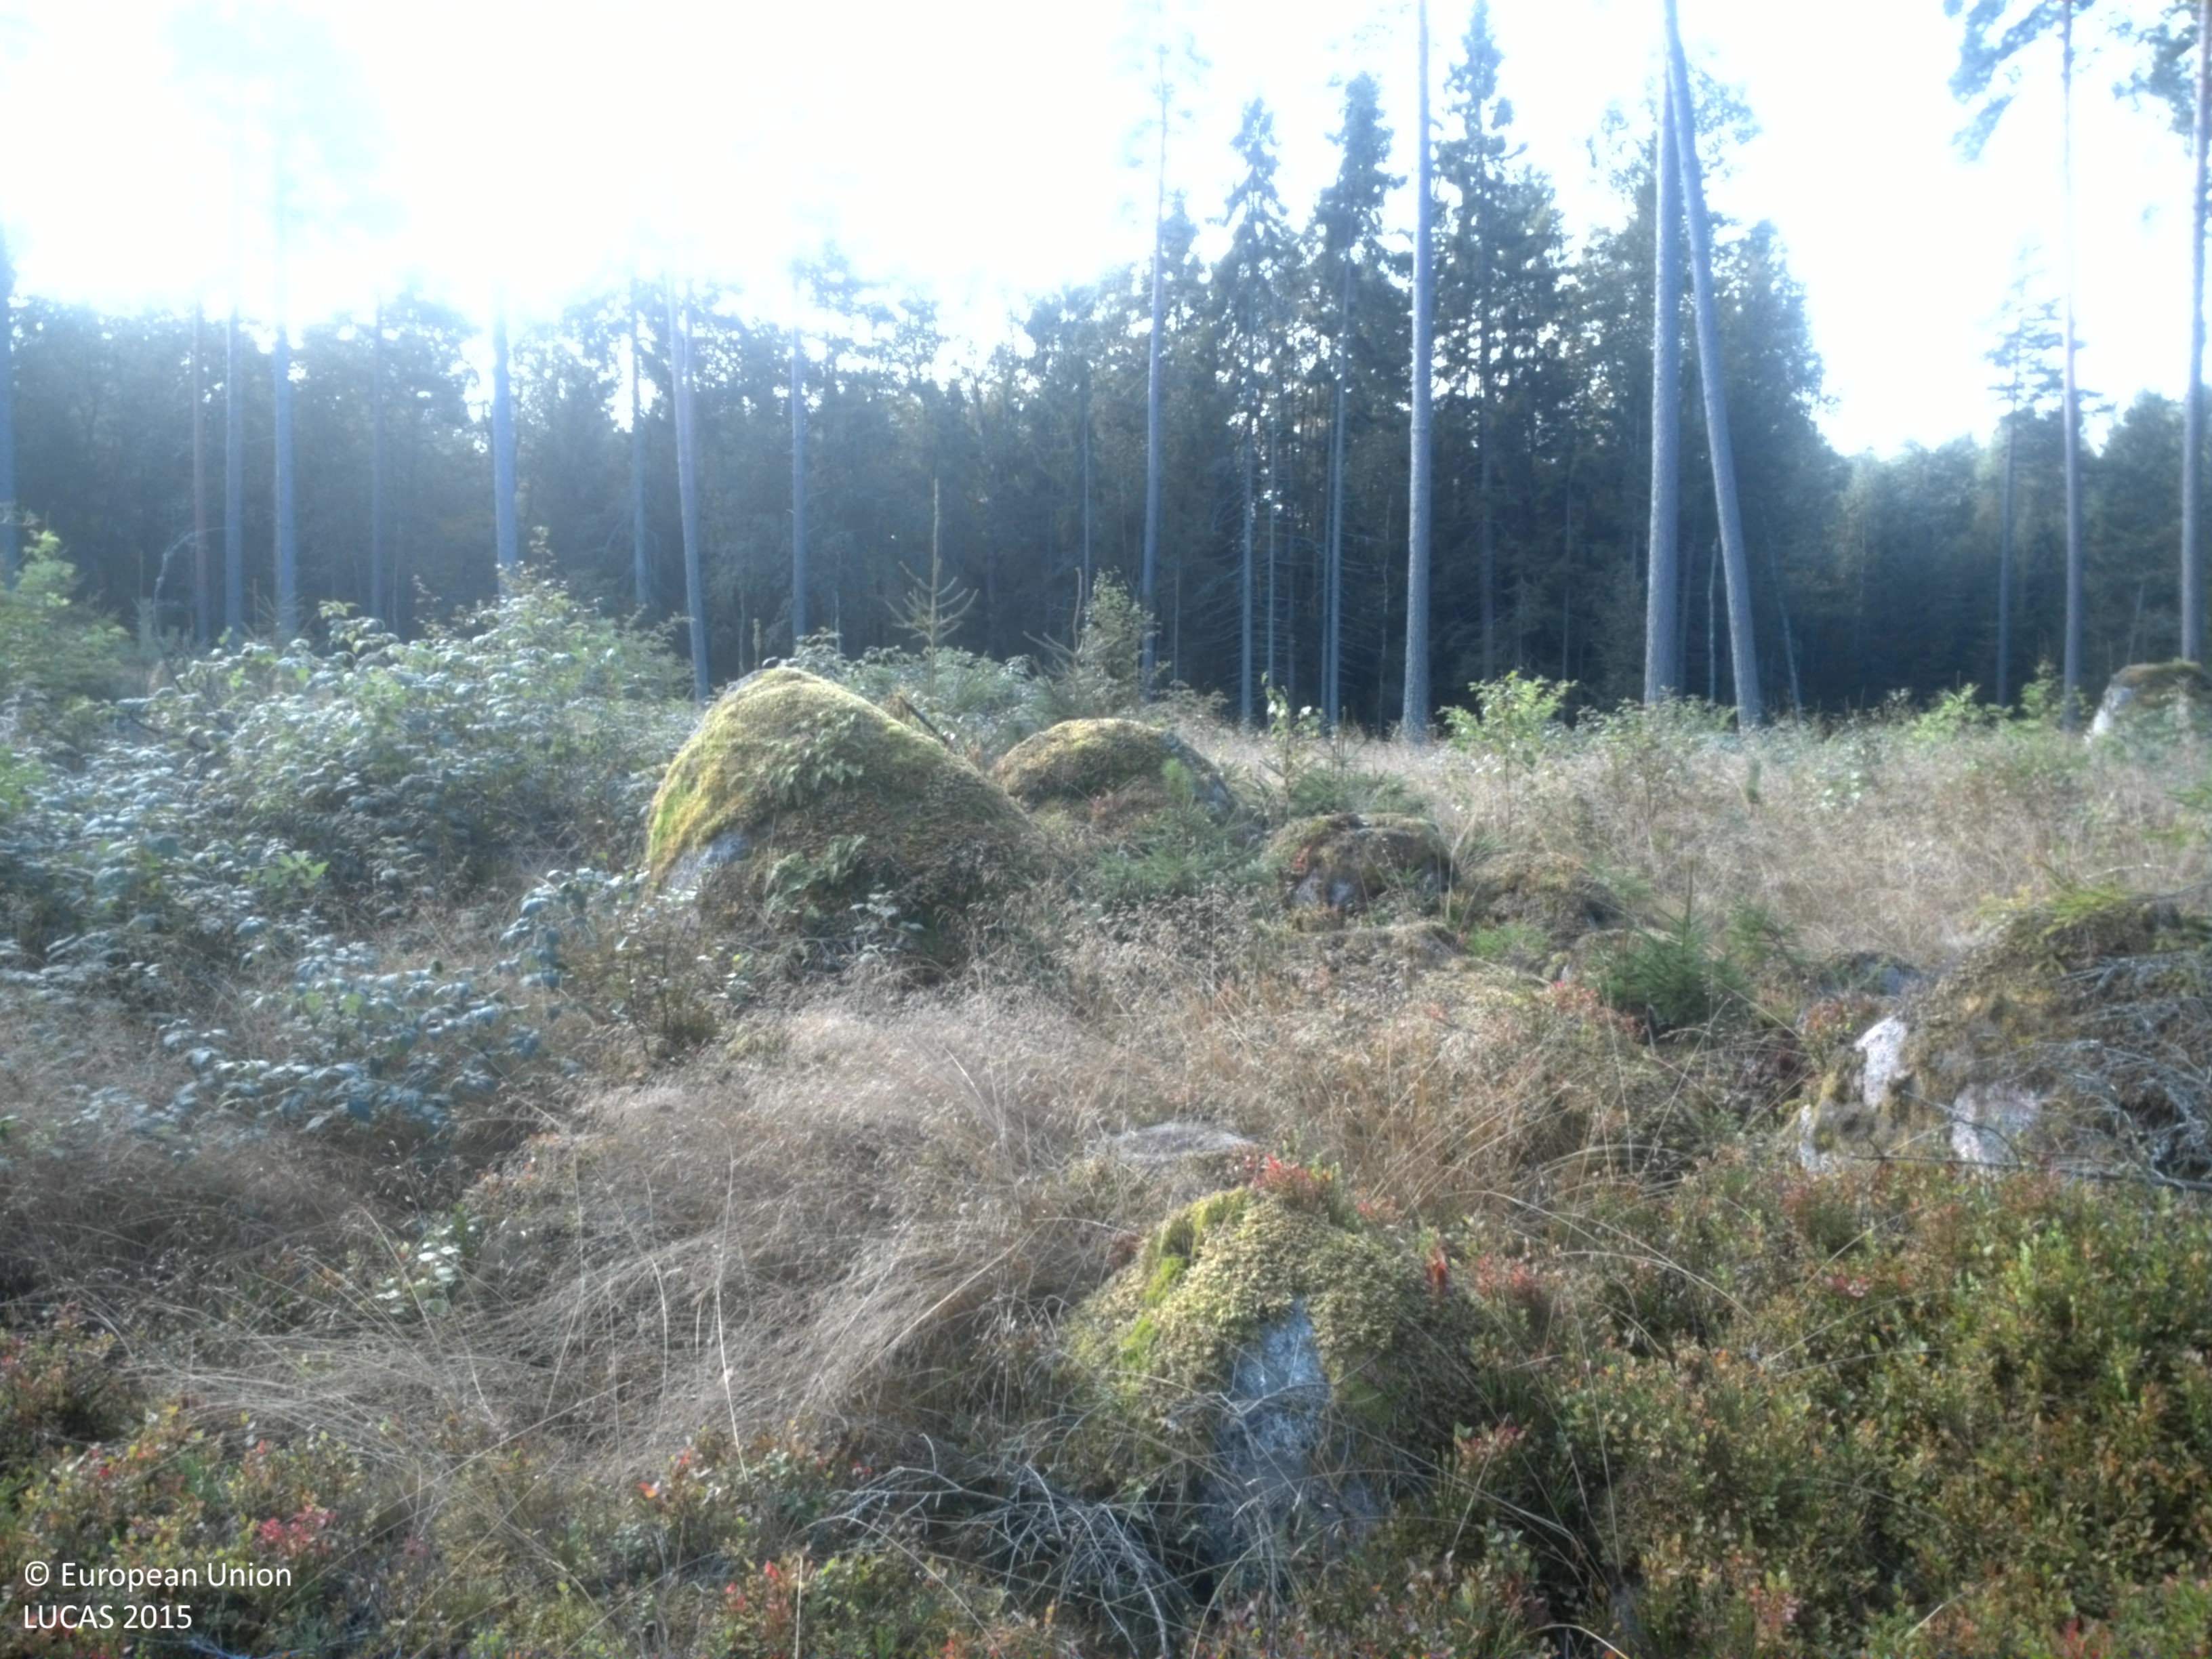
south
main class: Woodland
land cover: Pine dominated coniferous woodland
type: boreal forest
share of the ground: 50 - 75 %
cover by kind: coniferous forest trees 50 %, shrubs 25 %, herbaceous plants 15 %, broadleaved forest trees 5 %, lichens and mosses 5 %
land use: Forestry
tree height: > 5 m
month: September
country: SE
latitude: 59.5433
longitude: 15.6686
